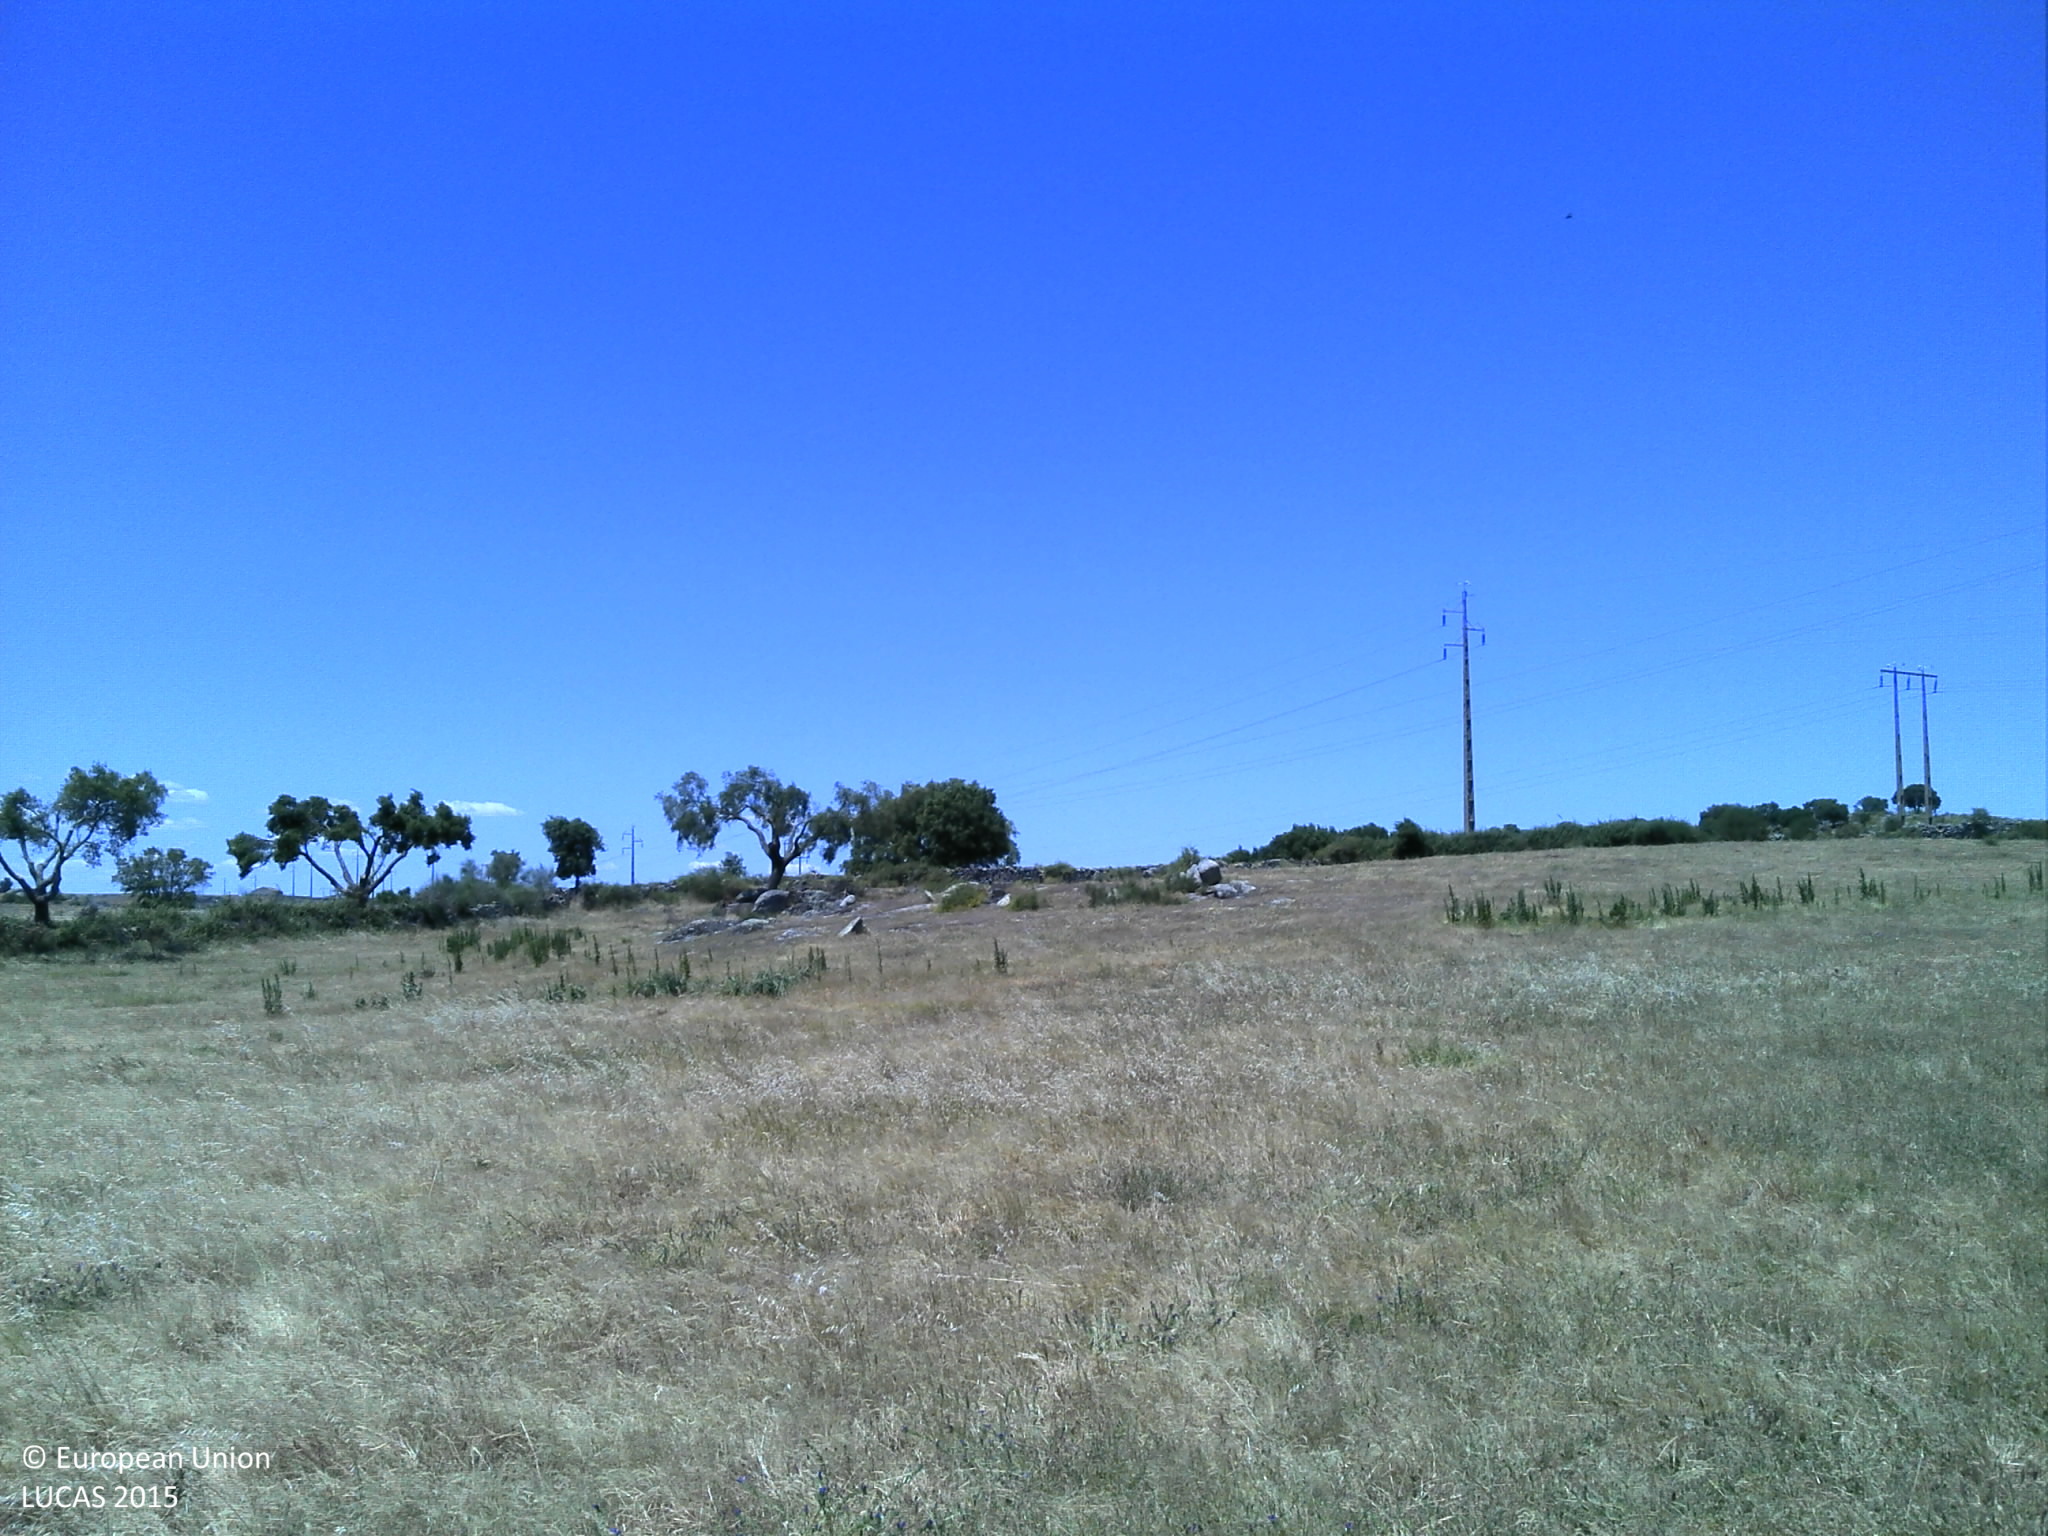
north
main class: Grassland
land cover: Grassland without tree/shrub cover
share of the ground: 50 - 75 %
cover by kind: herbaceous plants 75 %, unconsolidated bare surface 25 %
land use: Agriculture (excluding fallow land and kitchen gardens)
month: May
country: PT
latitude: 39.4462
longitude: -7.6539
